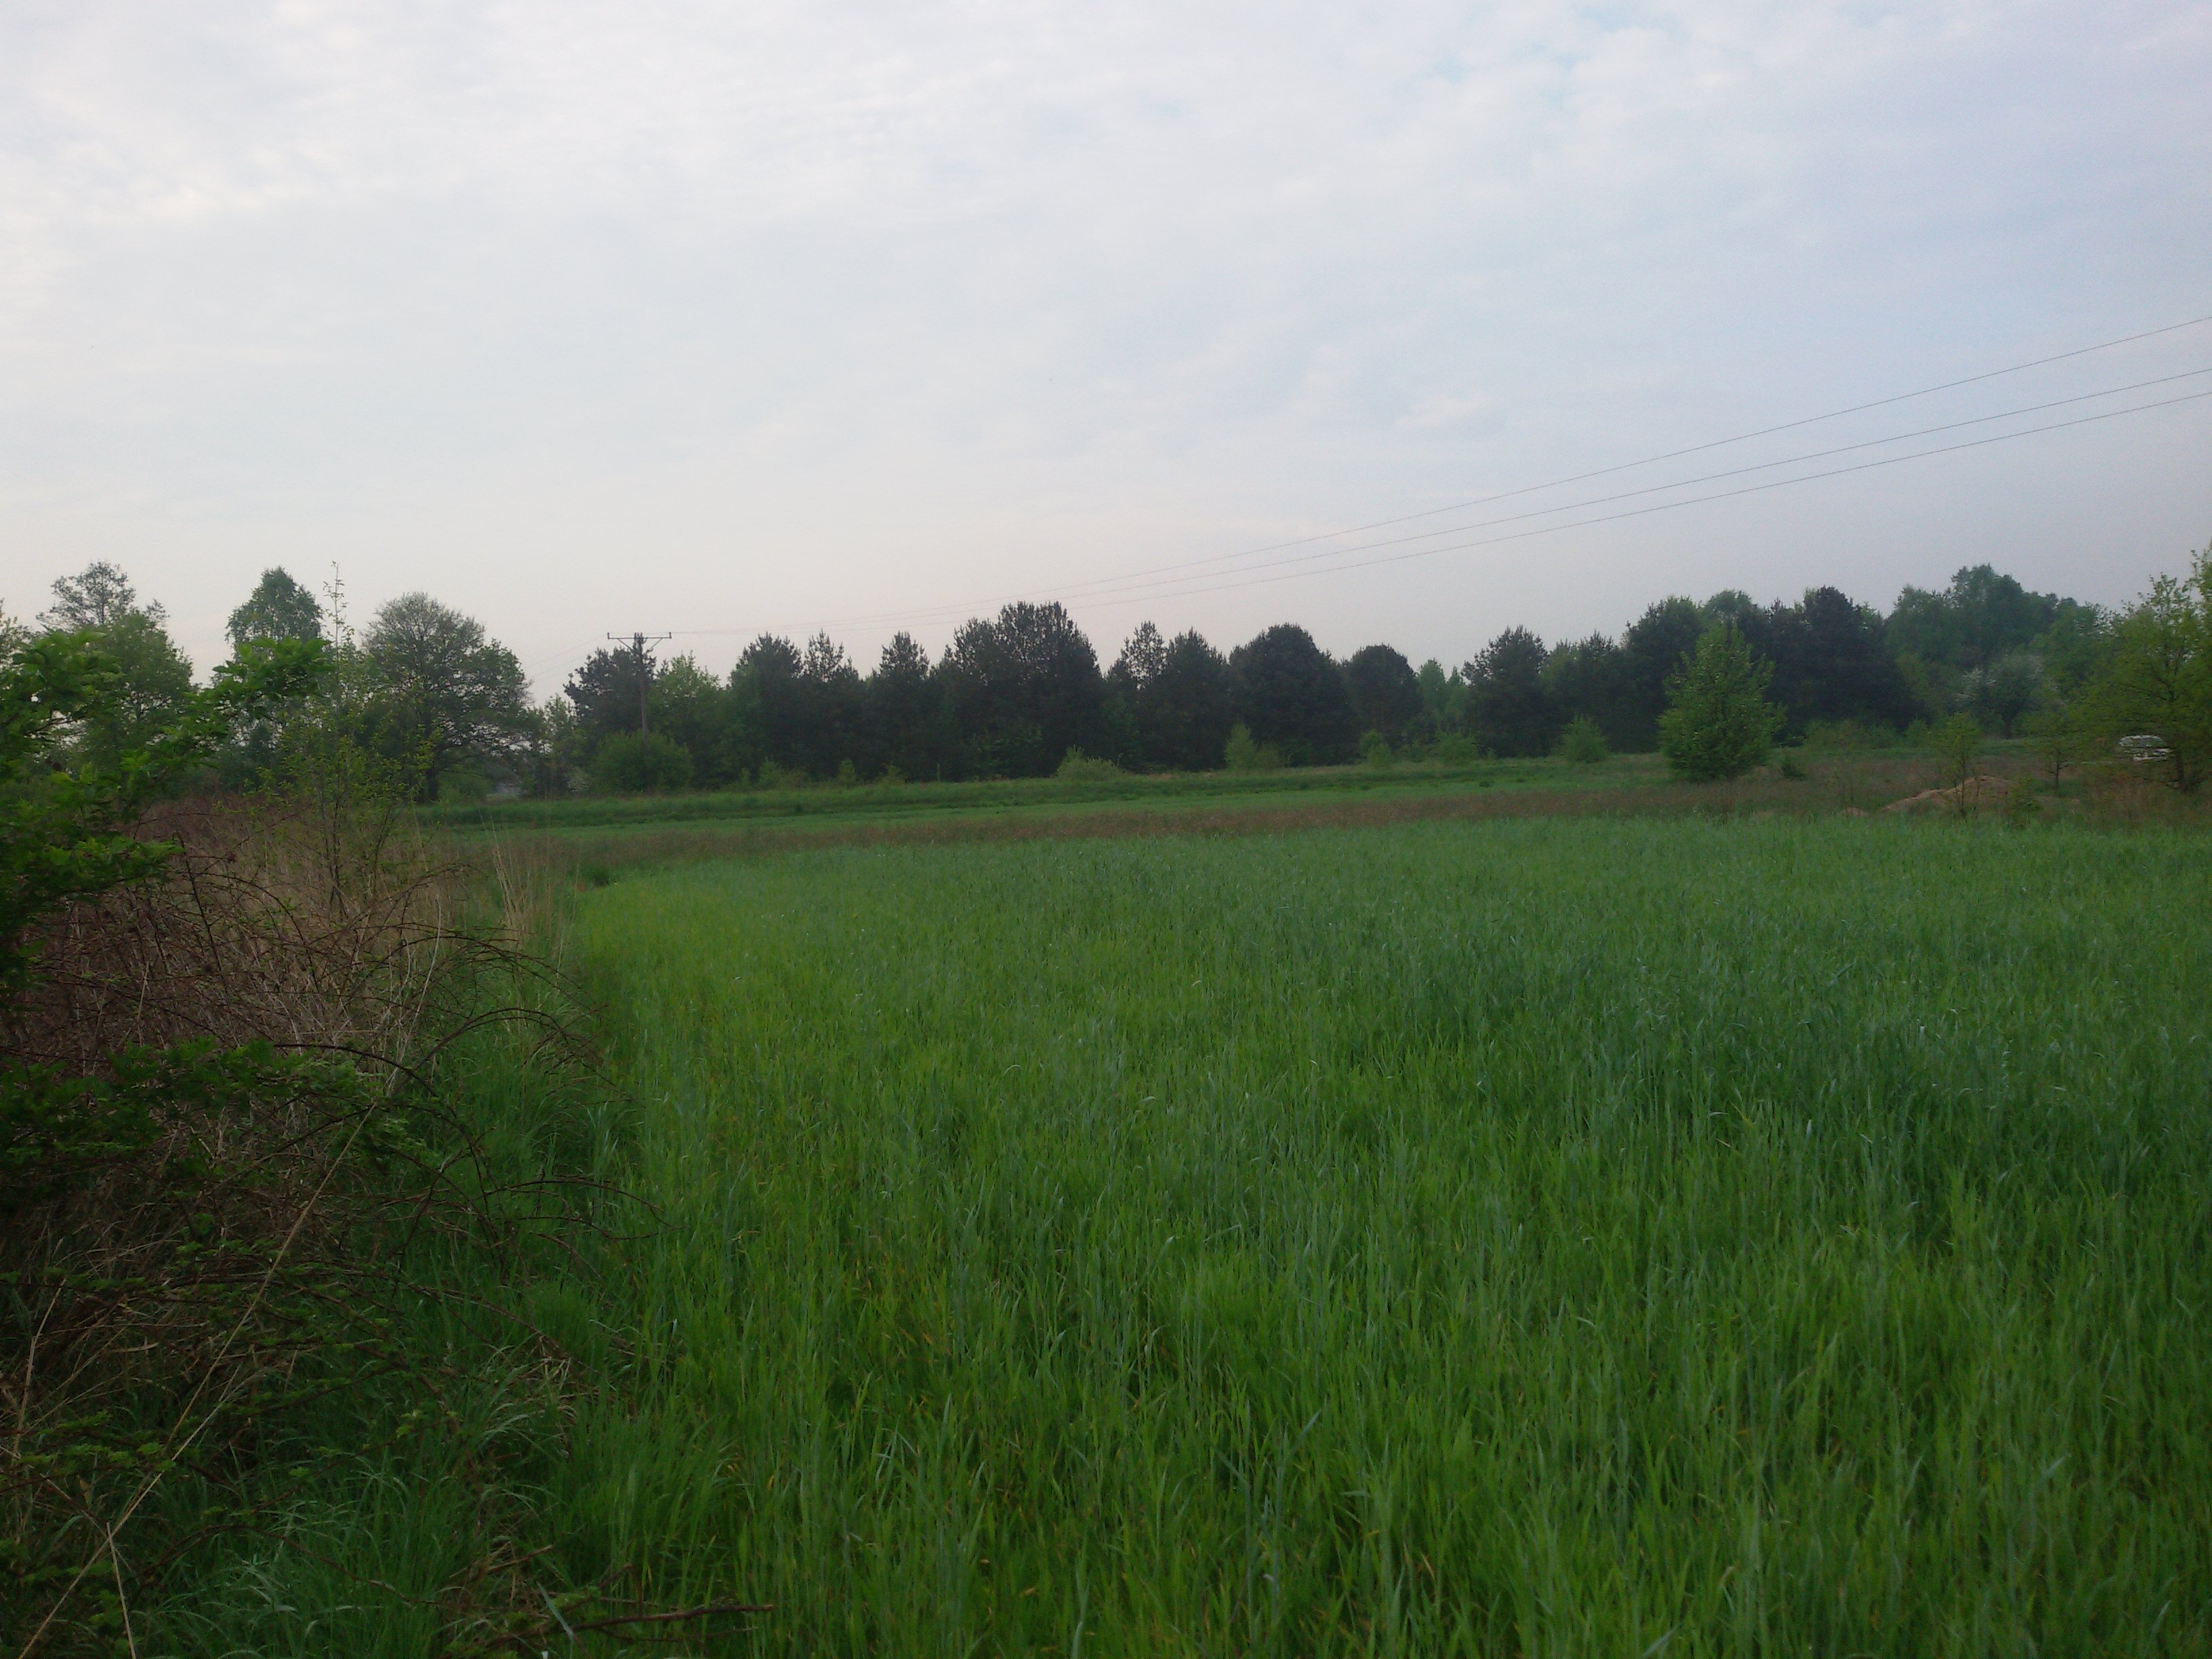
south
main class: Grassland
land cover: Spontaneously vegetated surfaces
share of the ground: > 75 %
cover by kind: herbaceous plants 95 %, shrubs 5 %
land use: Semi-natural and natural areas not in use
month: May
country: PL
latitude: 50.4780
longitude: 21.6217
